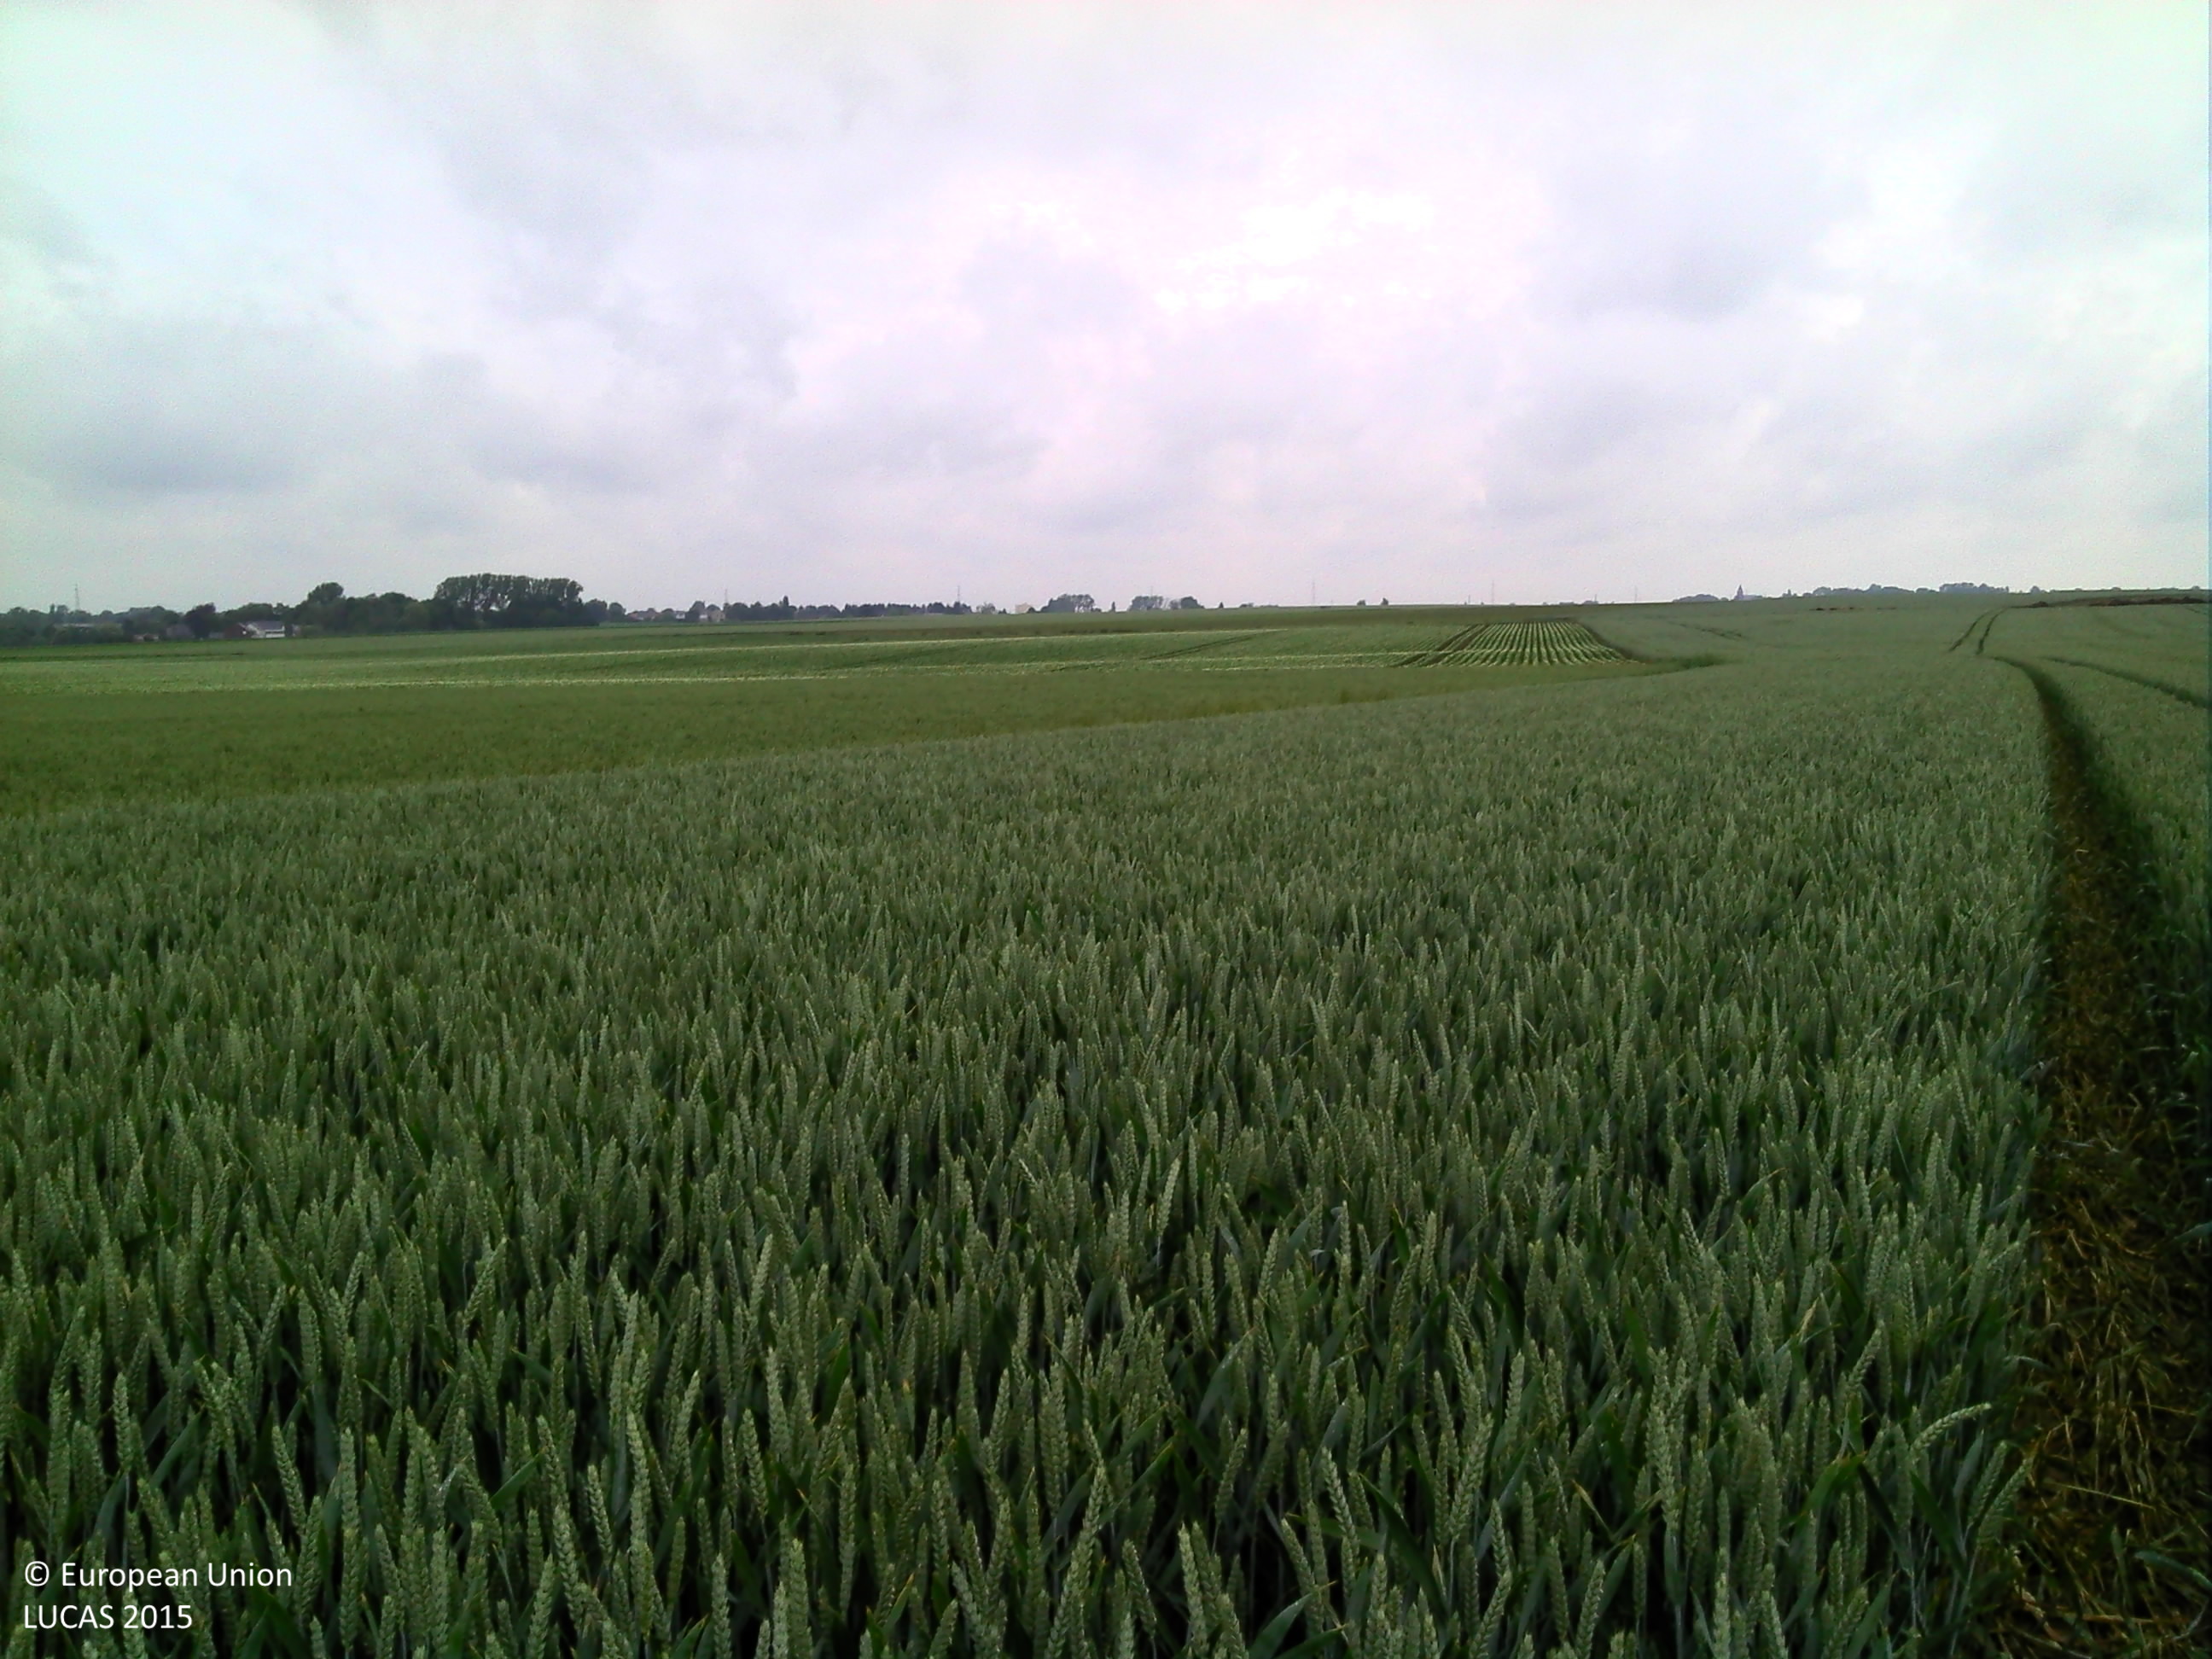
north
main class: Cropland
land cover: Common wheat
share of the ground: > 75 %
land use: Agriculture (excluding fallow land and kitchen gardens)
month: June
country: BE
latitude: 50.6880
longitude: 5.4544
